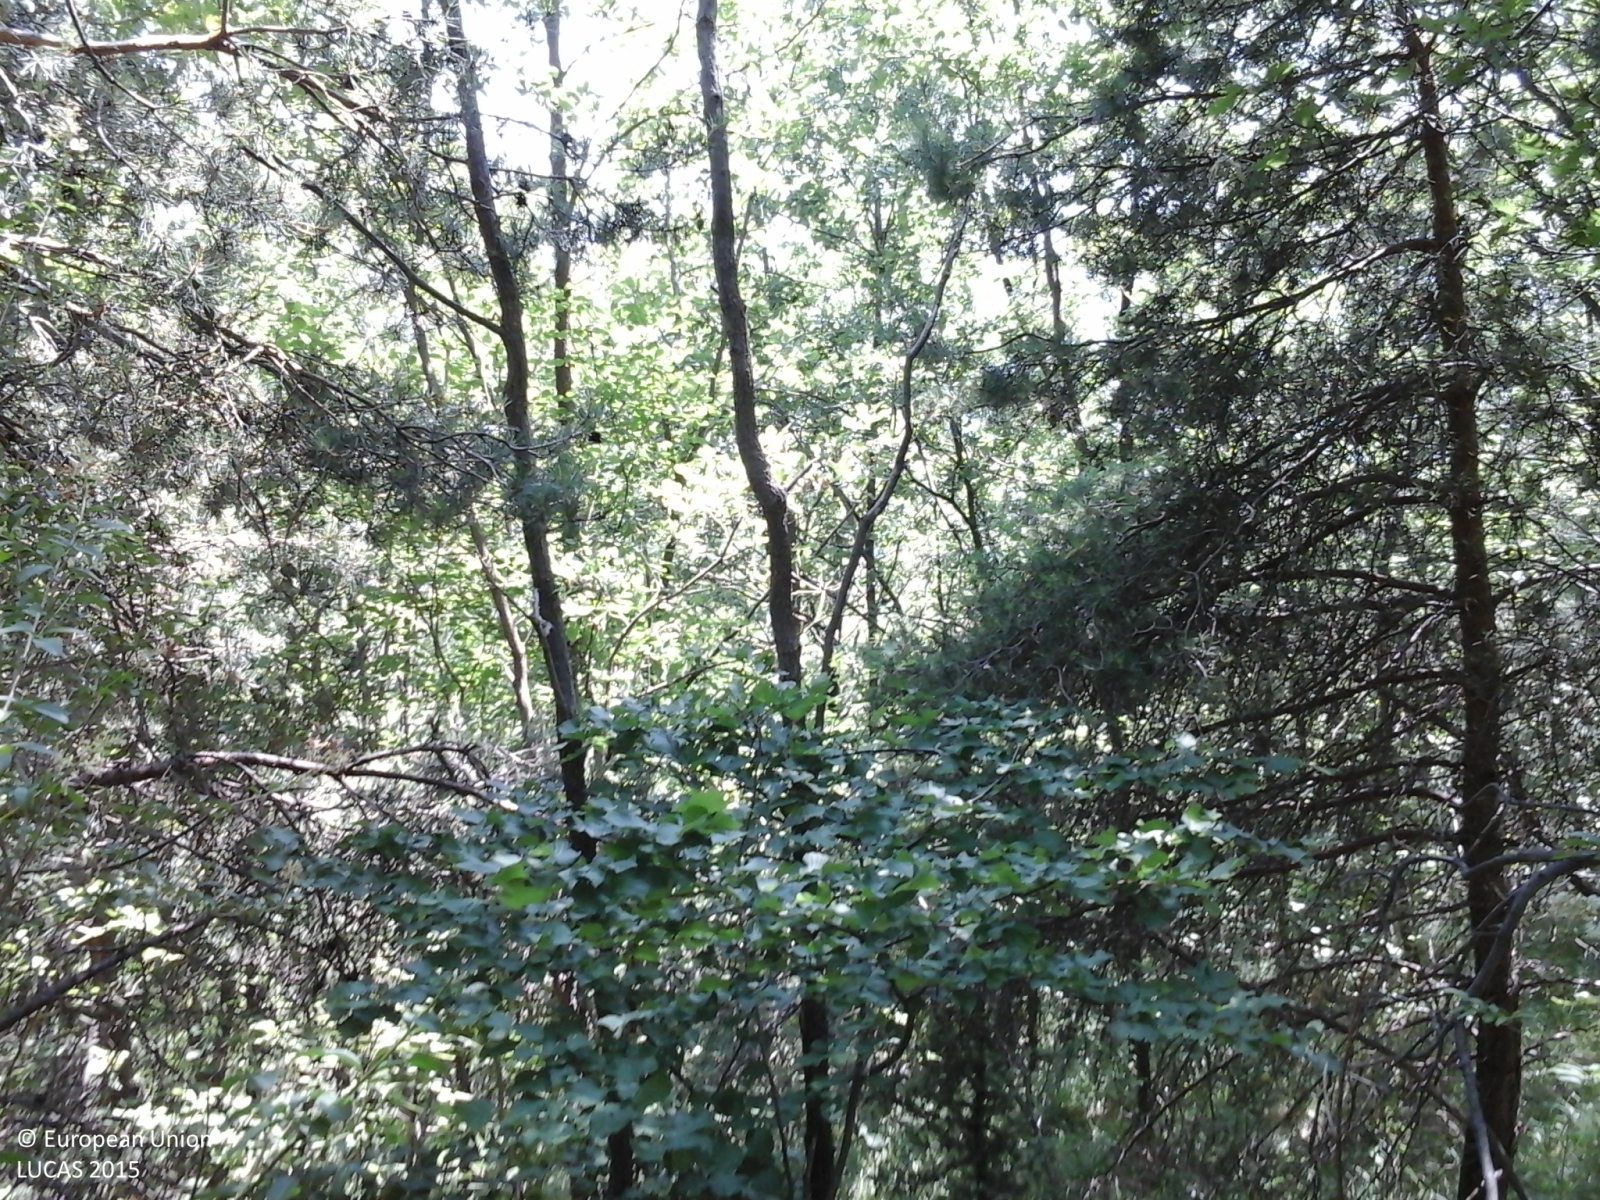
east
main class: Woodland
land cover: Broadleaved woodland
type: mesophytic deciduous forest
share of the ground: > 75 %
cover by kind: broadleaved forest trees 90 %, shrubs 5 %, herbaceous plants 5 %
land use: Forestry
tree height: > 5 m
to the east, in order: Broadleaved woodland; Vineyards; Tracks; Vineyards; Dry stone walls; Vineyards; Dry stone walls; Paved roads, cycling and walking lanes; Grass margins; Vineyards; Electric lines; Vineyards
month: June
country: IT
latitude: 44.6605
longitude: 8.2506
